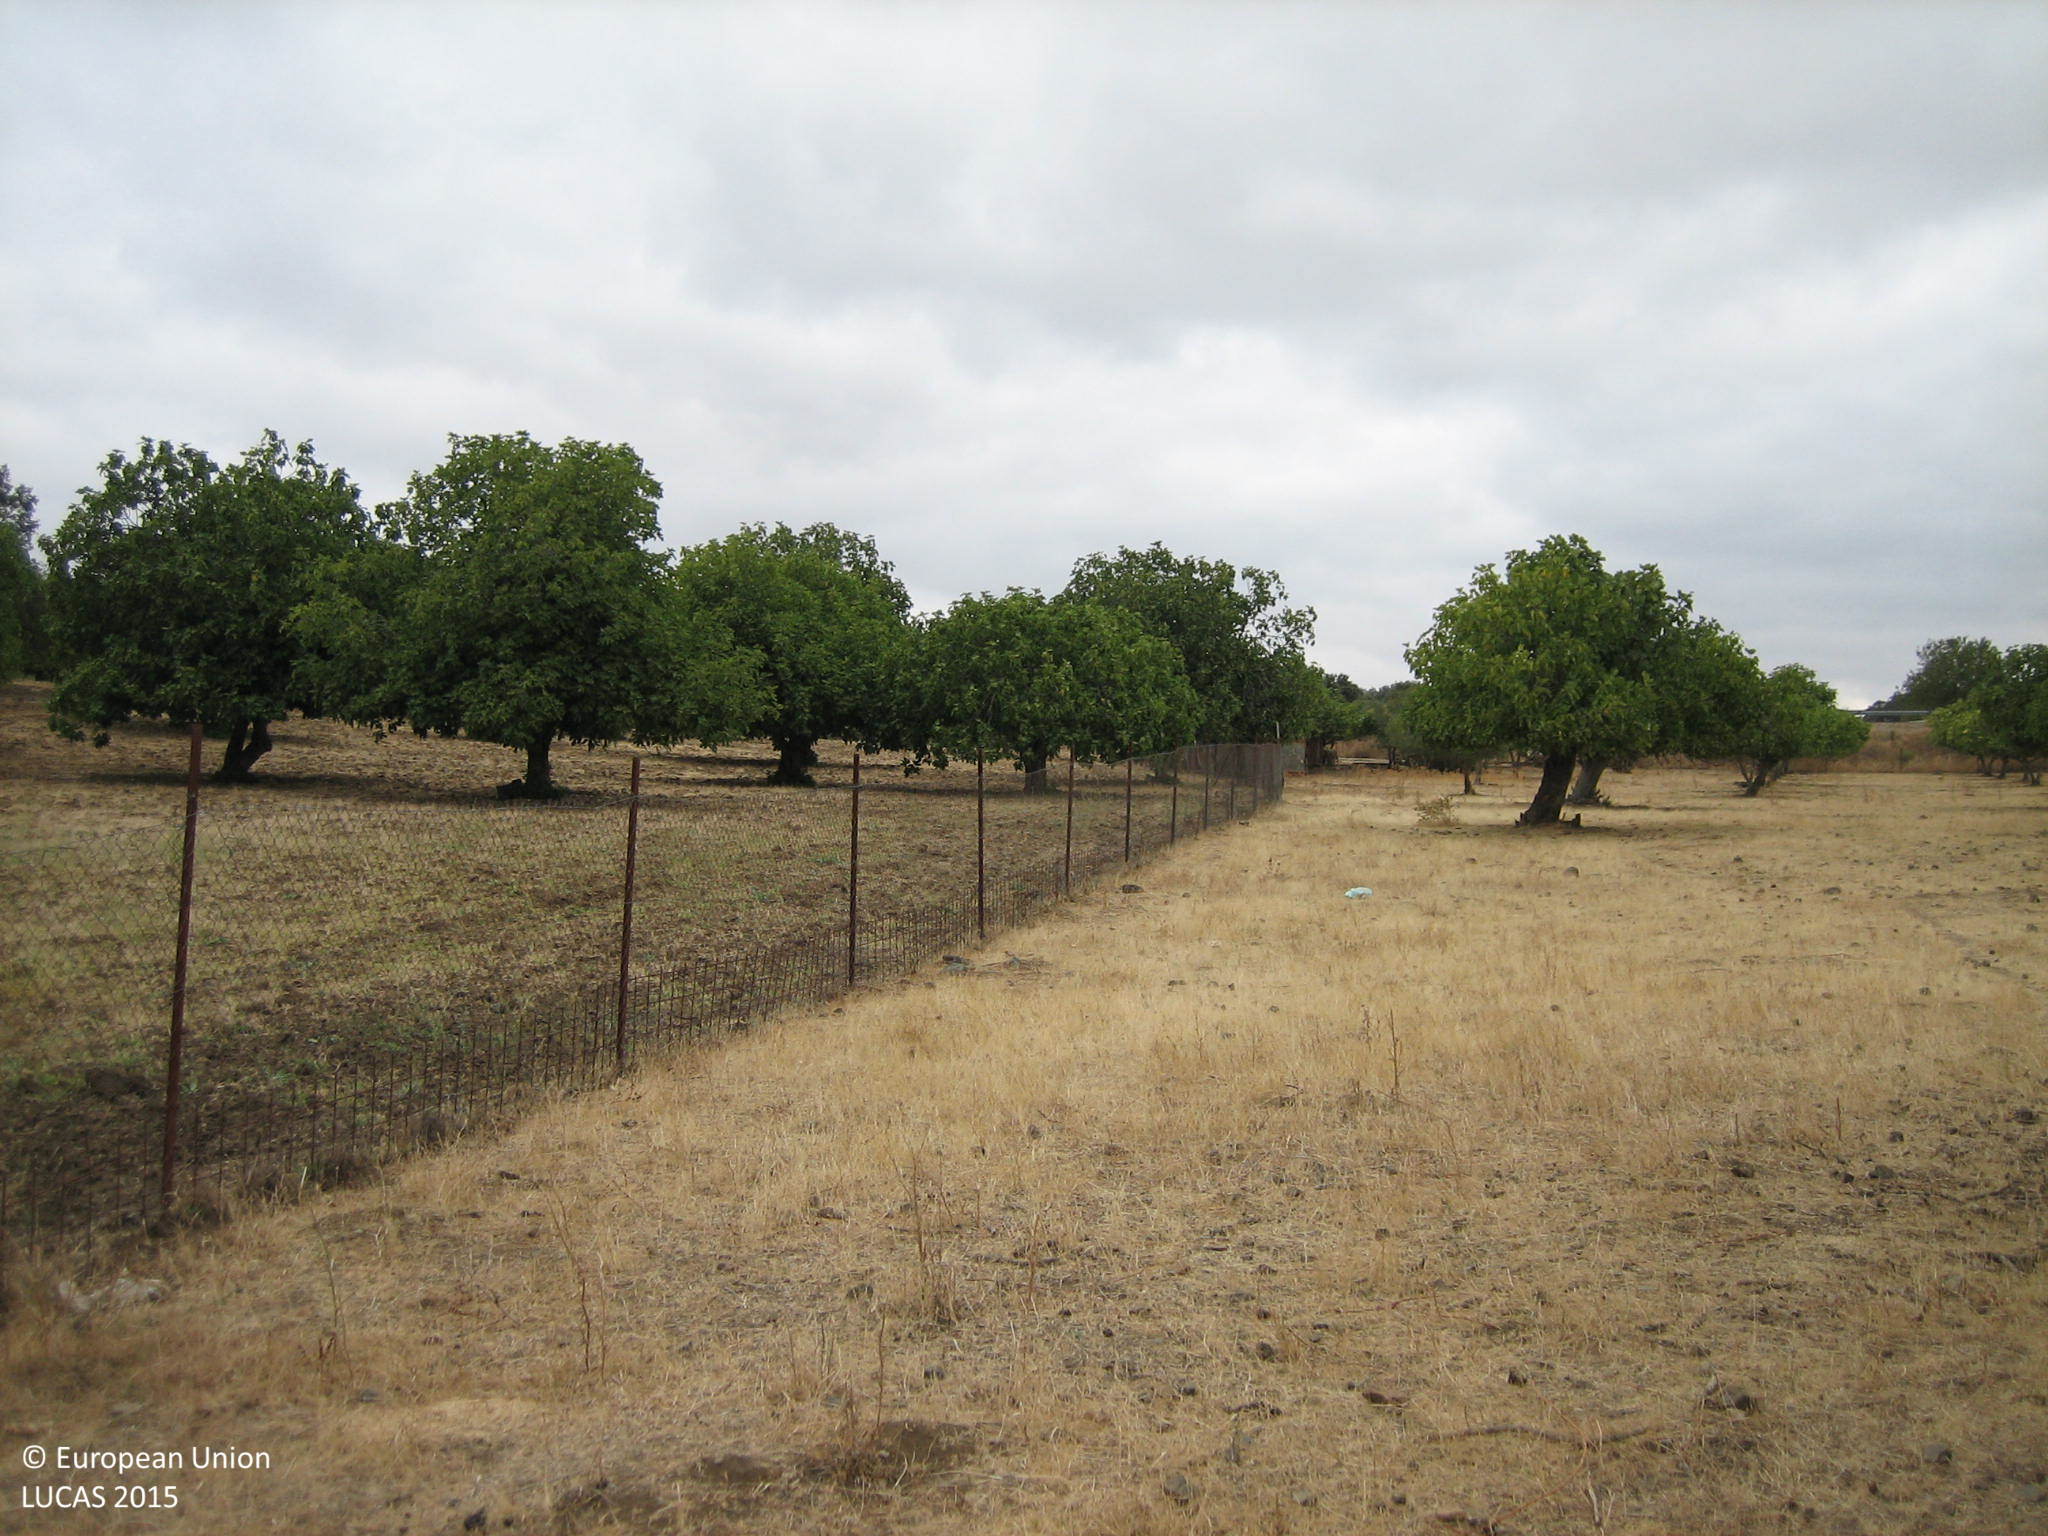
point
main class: Cropland
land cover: Other fruit trees and berries
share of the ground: 25 - 50 %
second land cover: Spontaneously vegetated surfaces
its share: 10 - 25 %
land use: Agriculture (excluding fallow land and kitchen gardens)
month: September
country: ES
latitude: 38.5190
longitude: -6.8636
